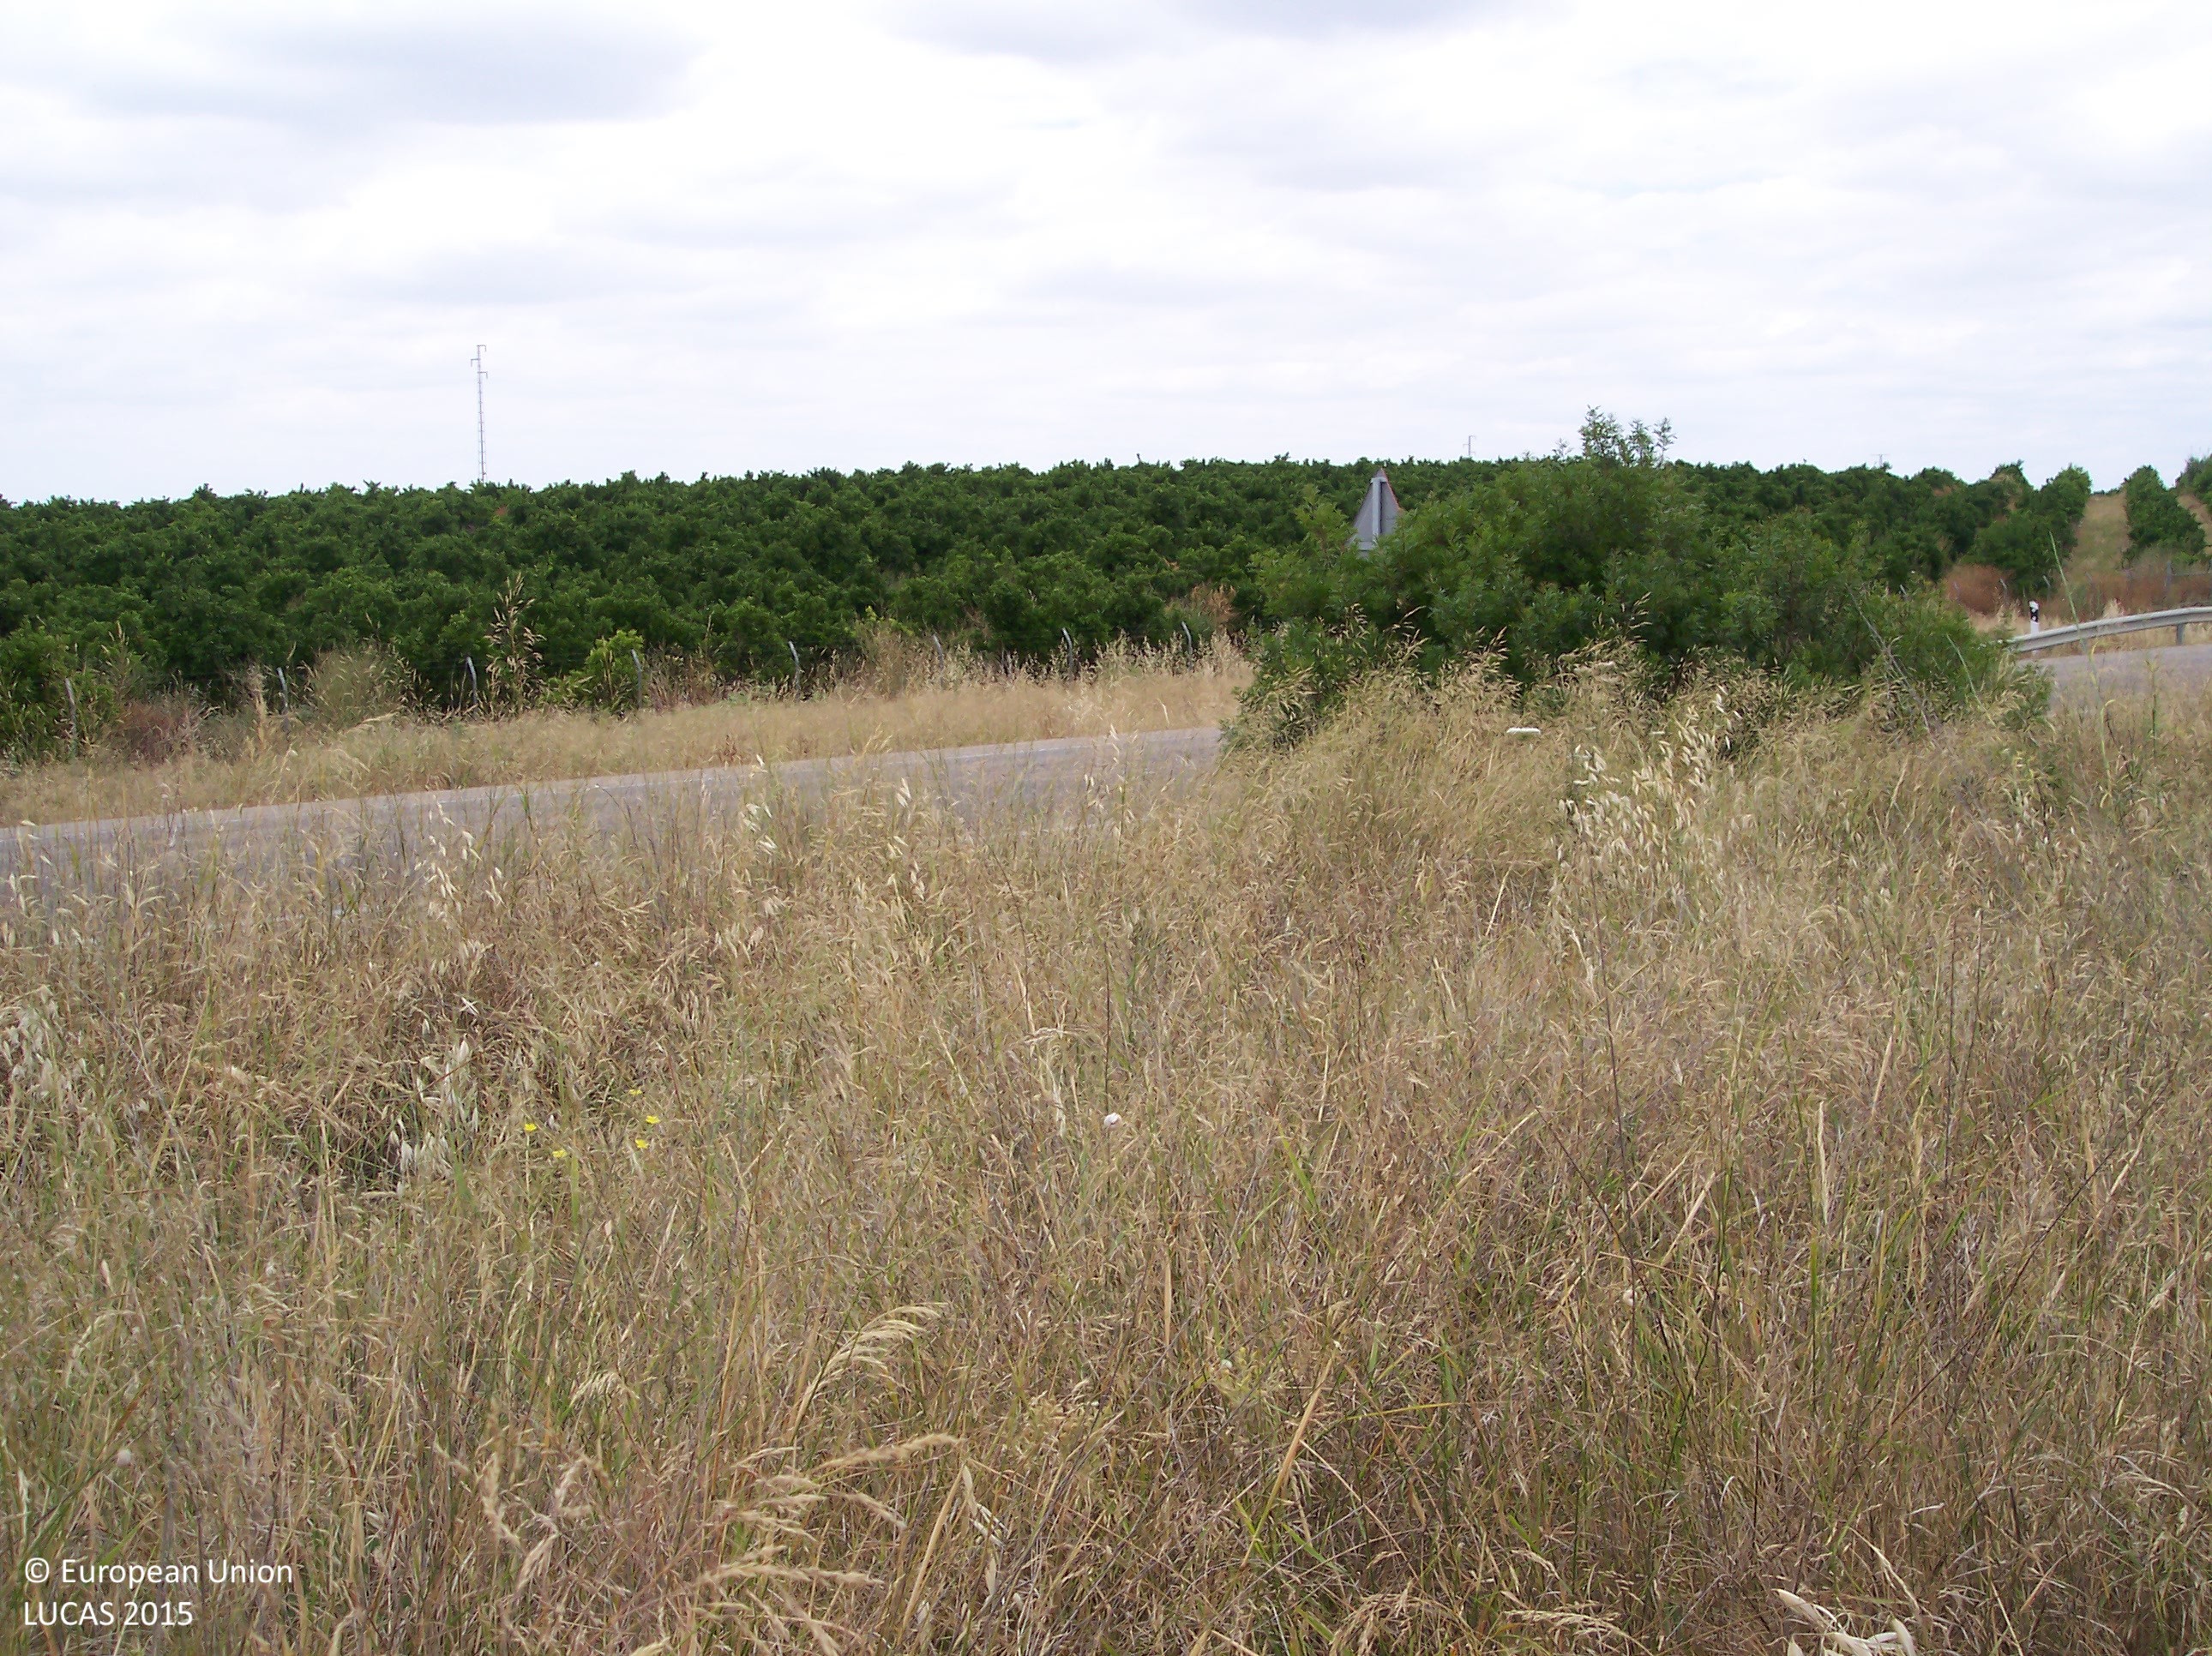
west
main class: Grassland
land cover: Grassland without tree/shrub cover
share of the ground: > 75 %
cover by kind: herbaceous plants 75 %, unconsolidated bare surface 20 %, shrubs 5 %
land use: Agriculture (excluding fallow land and kitchen gardens)
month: June
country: ES
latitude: 37.3135
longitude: -6.3786
